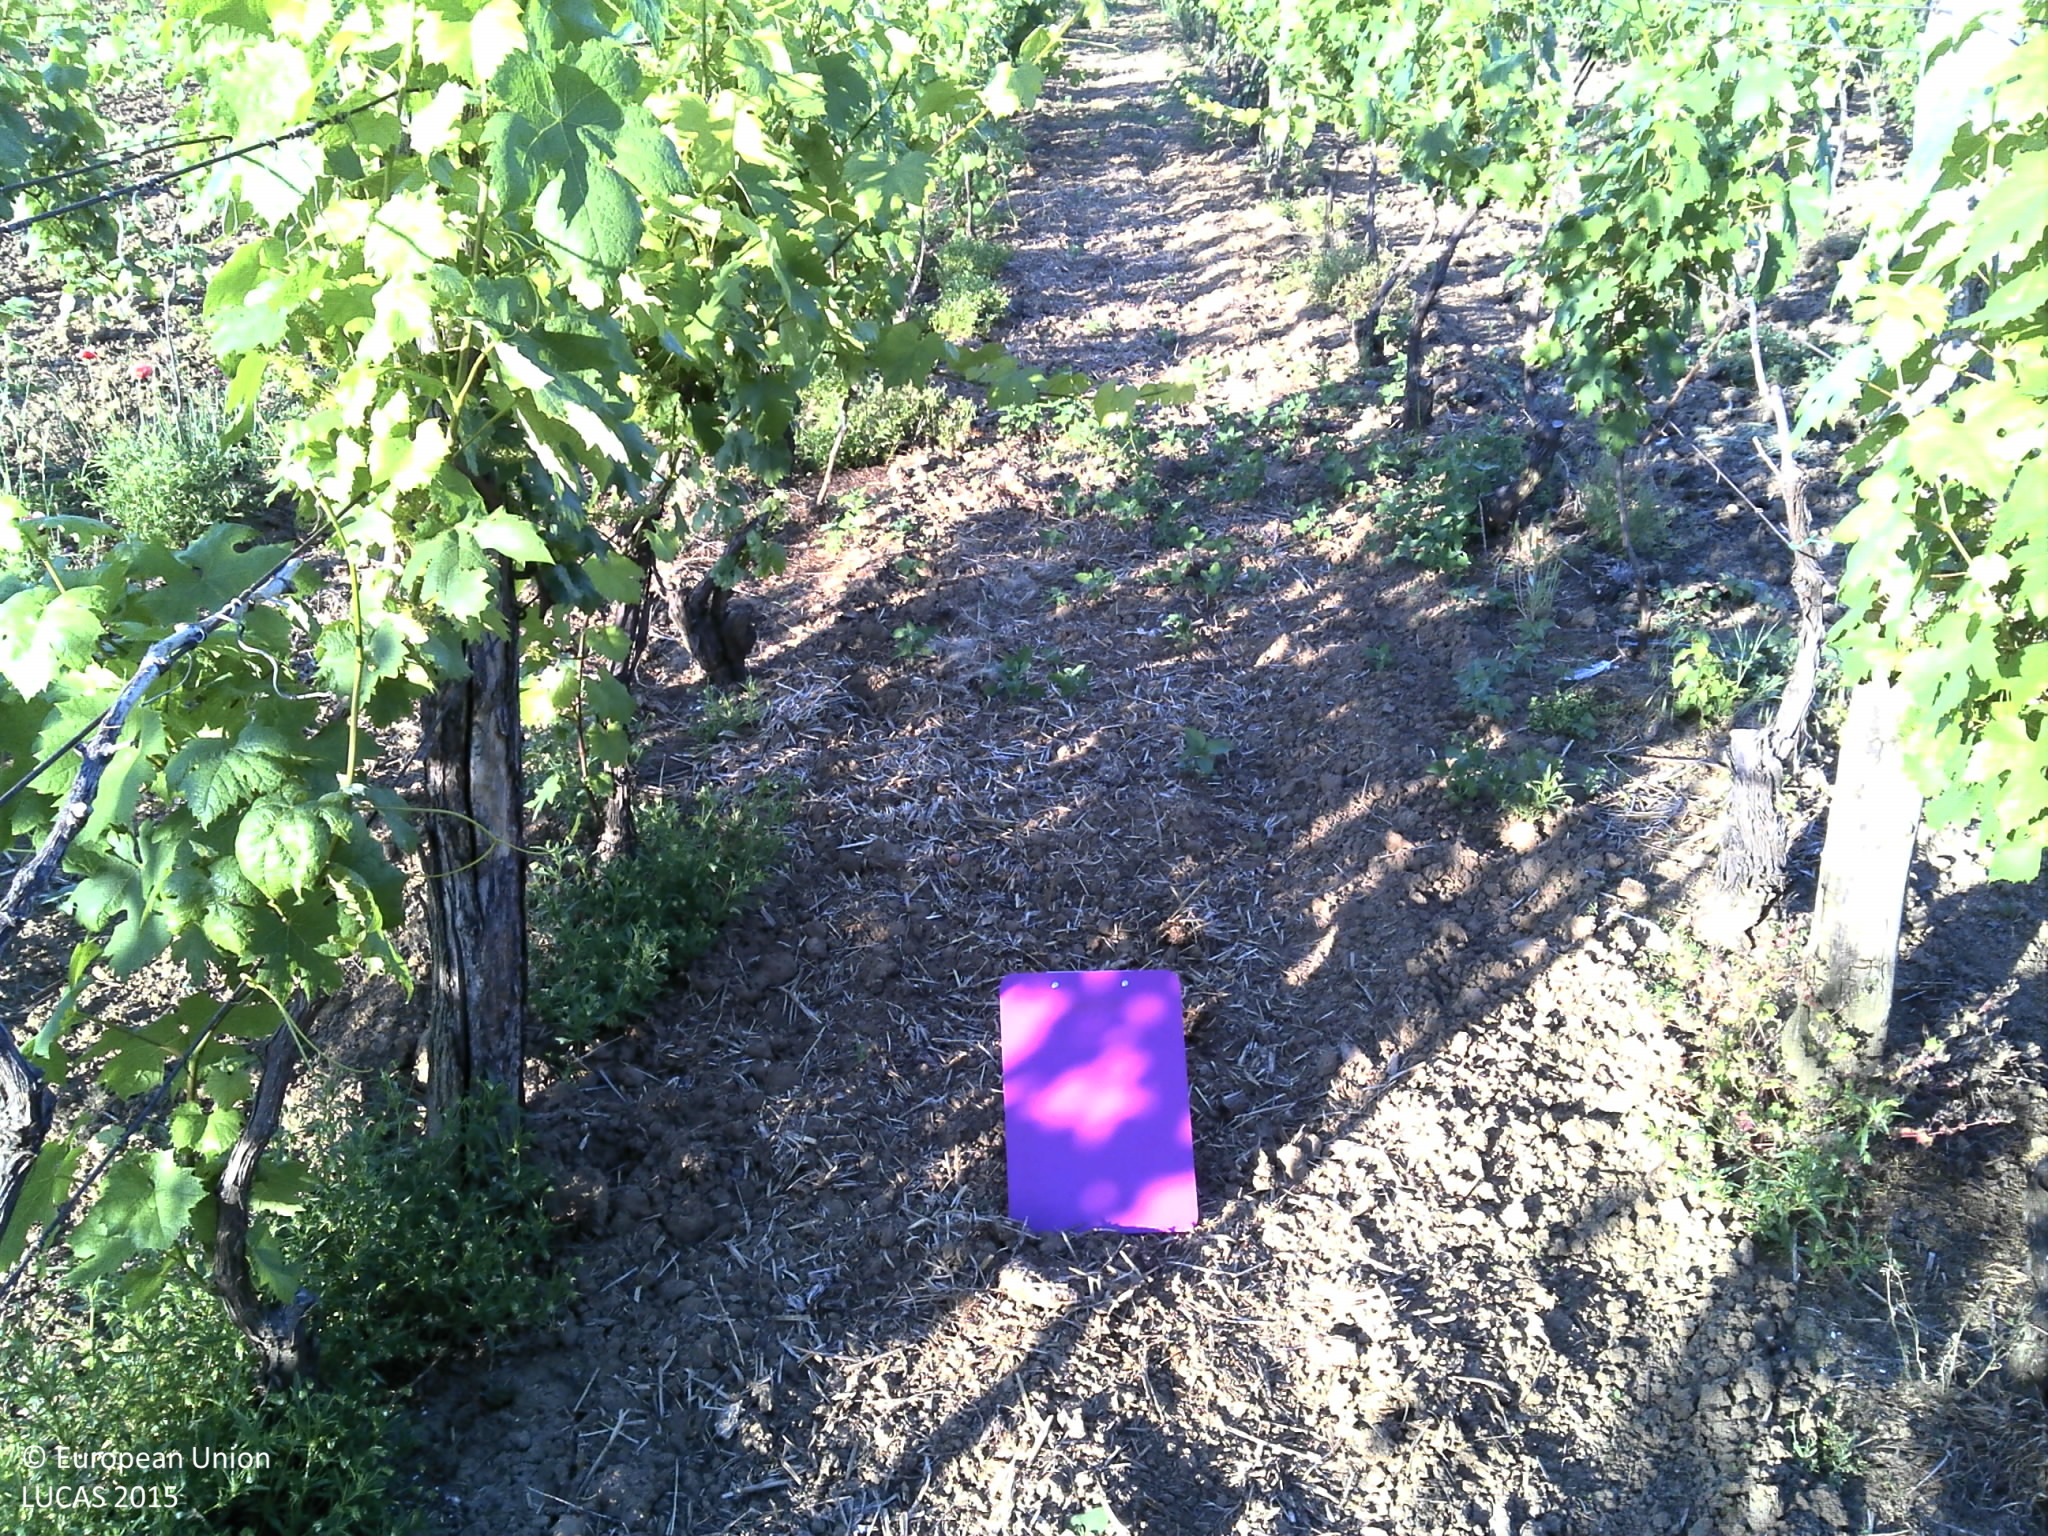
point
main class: Cropland
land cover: Vineyards
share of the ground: 10 - 25 %
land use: Agriculture (excluding fallow land and kitchen gardens)
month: June
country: HR
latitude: 45.2093
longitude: 19.4201
